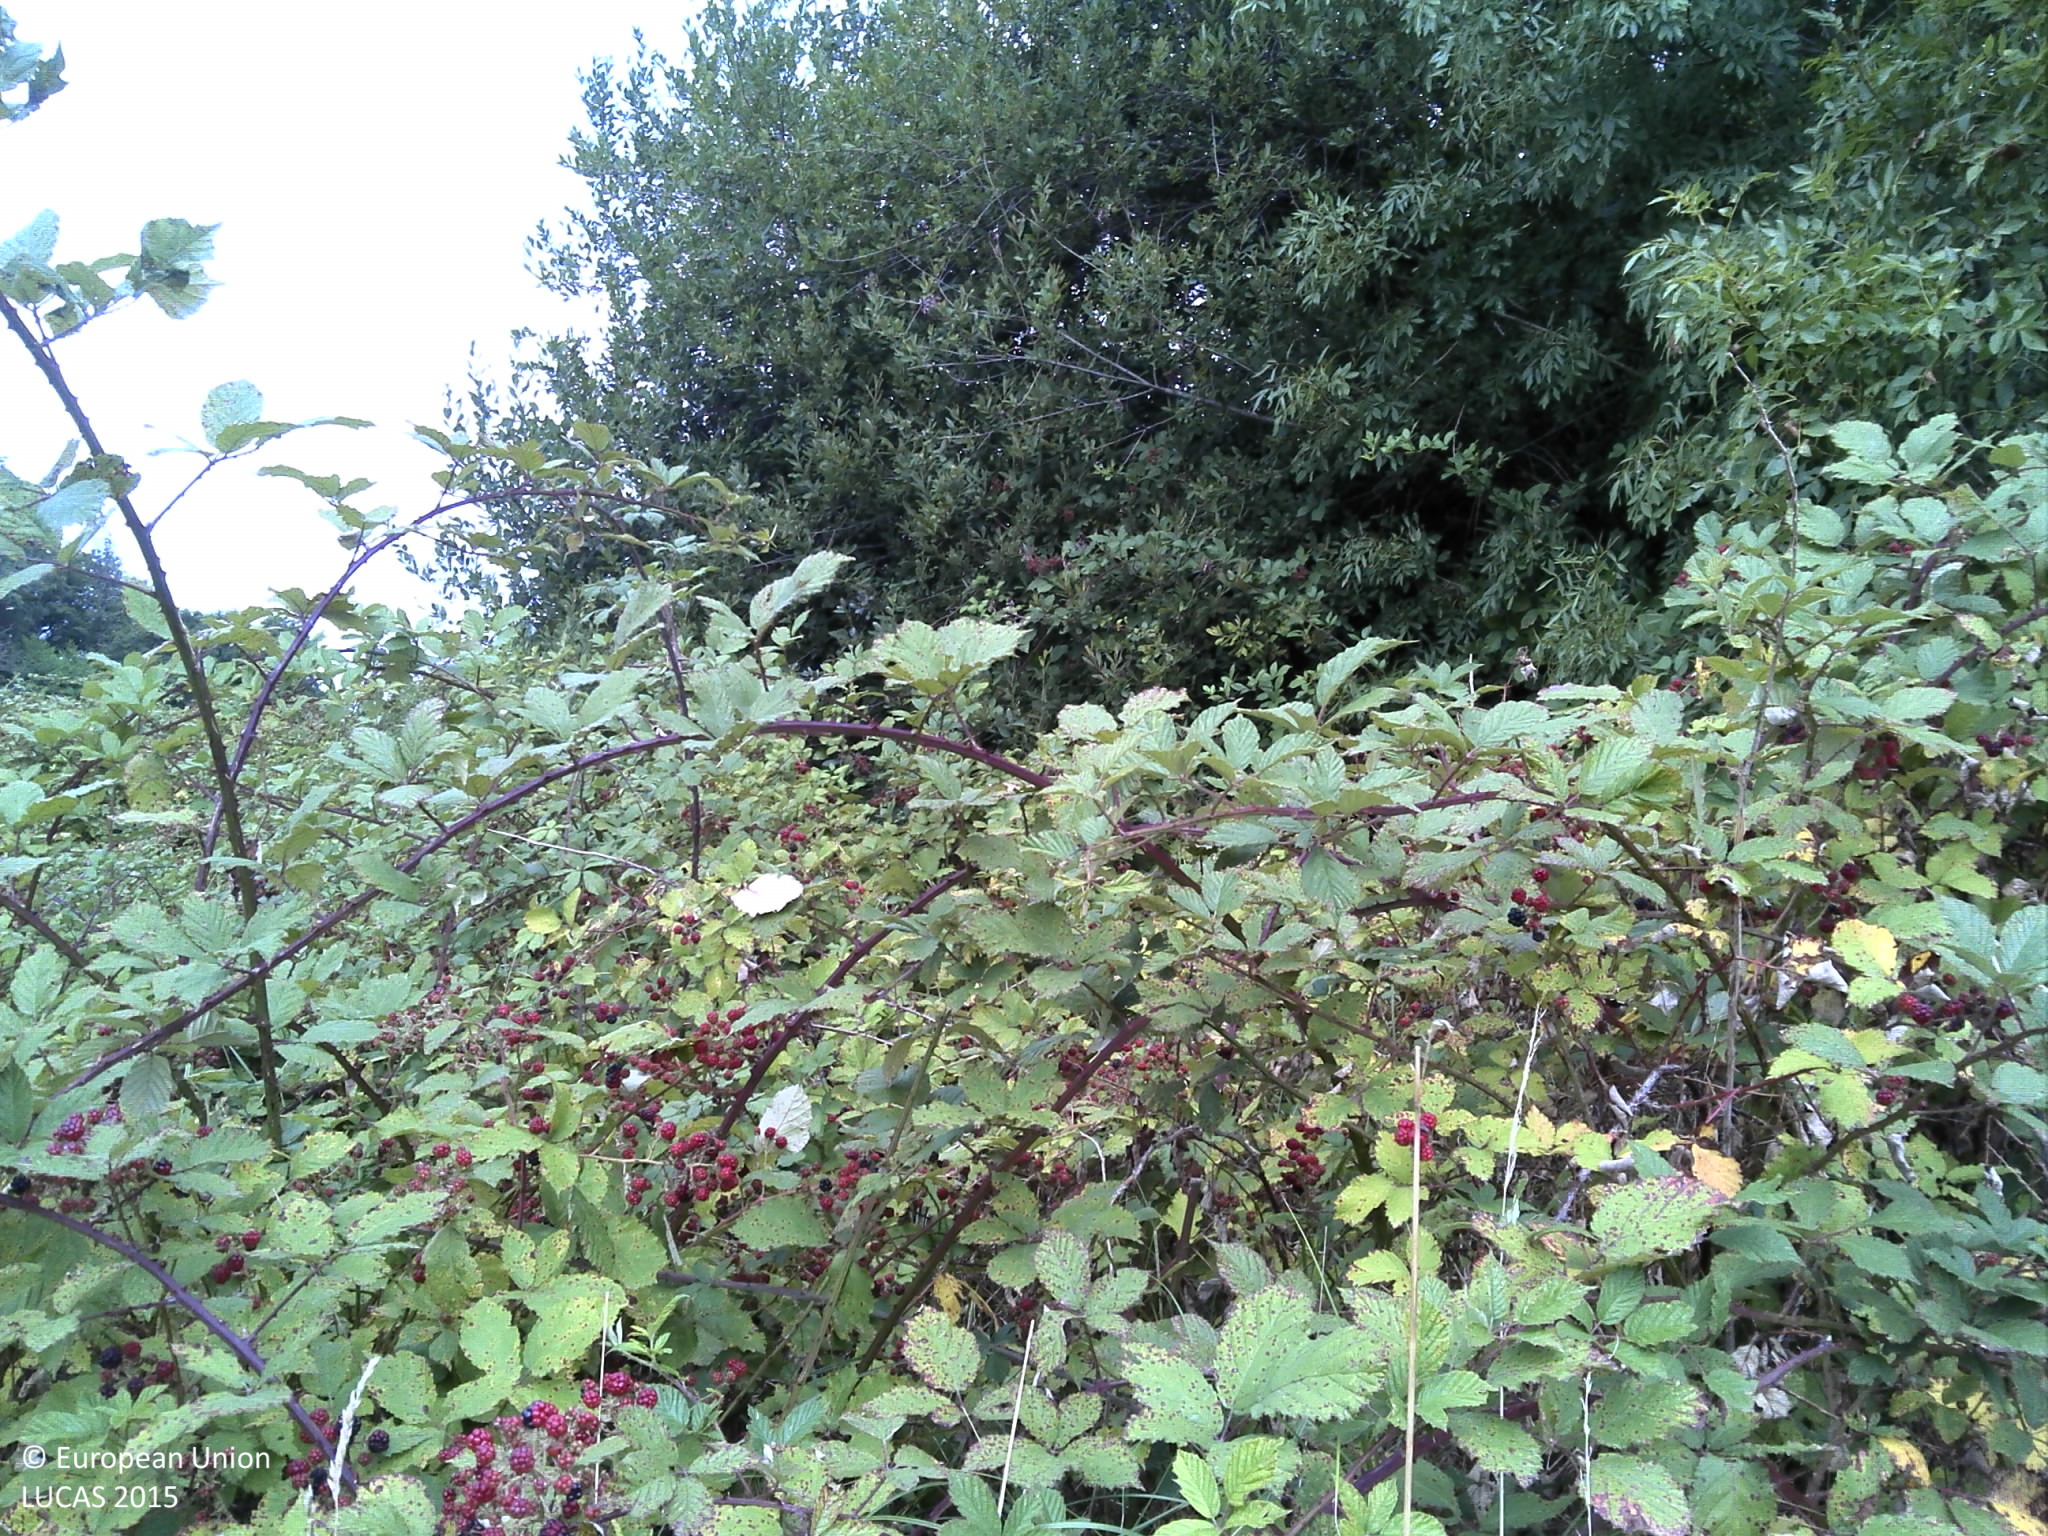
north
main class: Woodland
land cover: Broadleaved woodland
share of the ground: > 75 %
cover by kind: broadleaved forest trees 70 %, shrubs 30 %
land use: Semi-natural and natural areas not in use
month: August
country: FR
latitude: 45.2054
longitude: -0.6007
